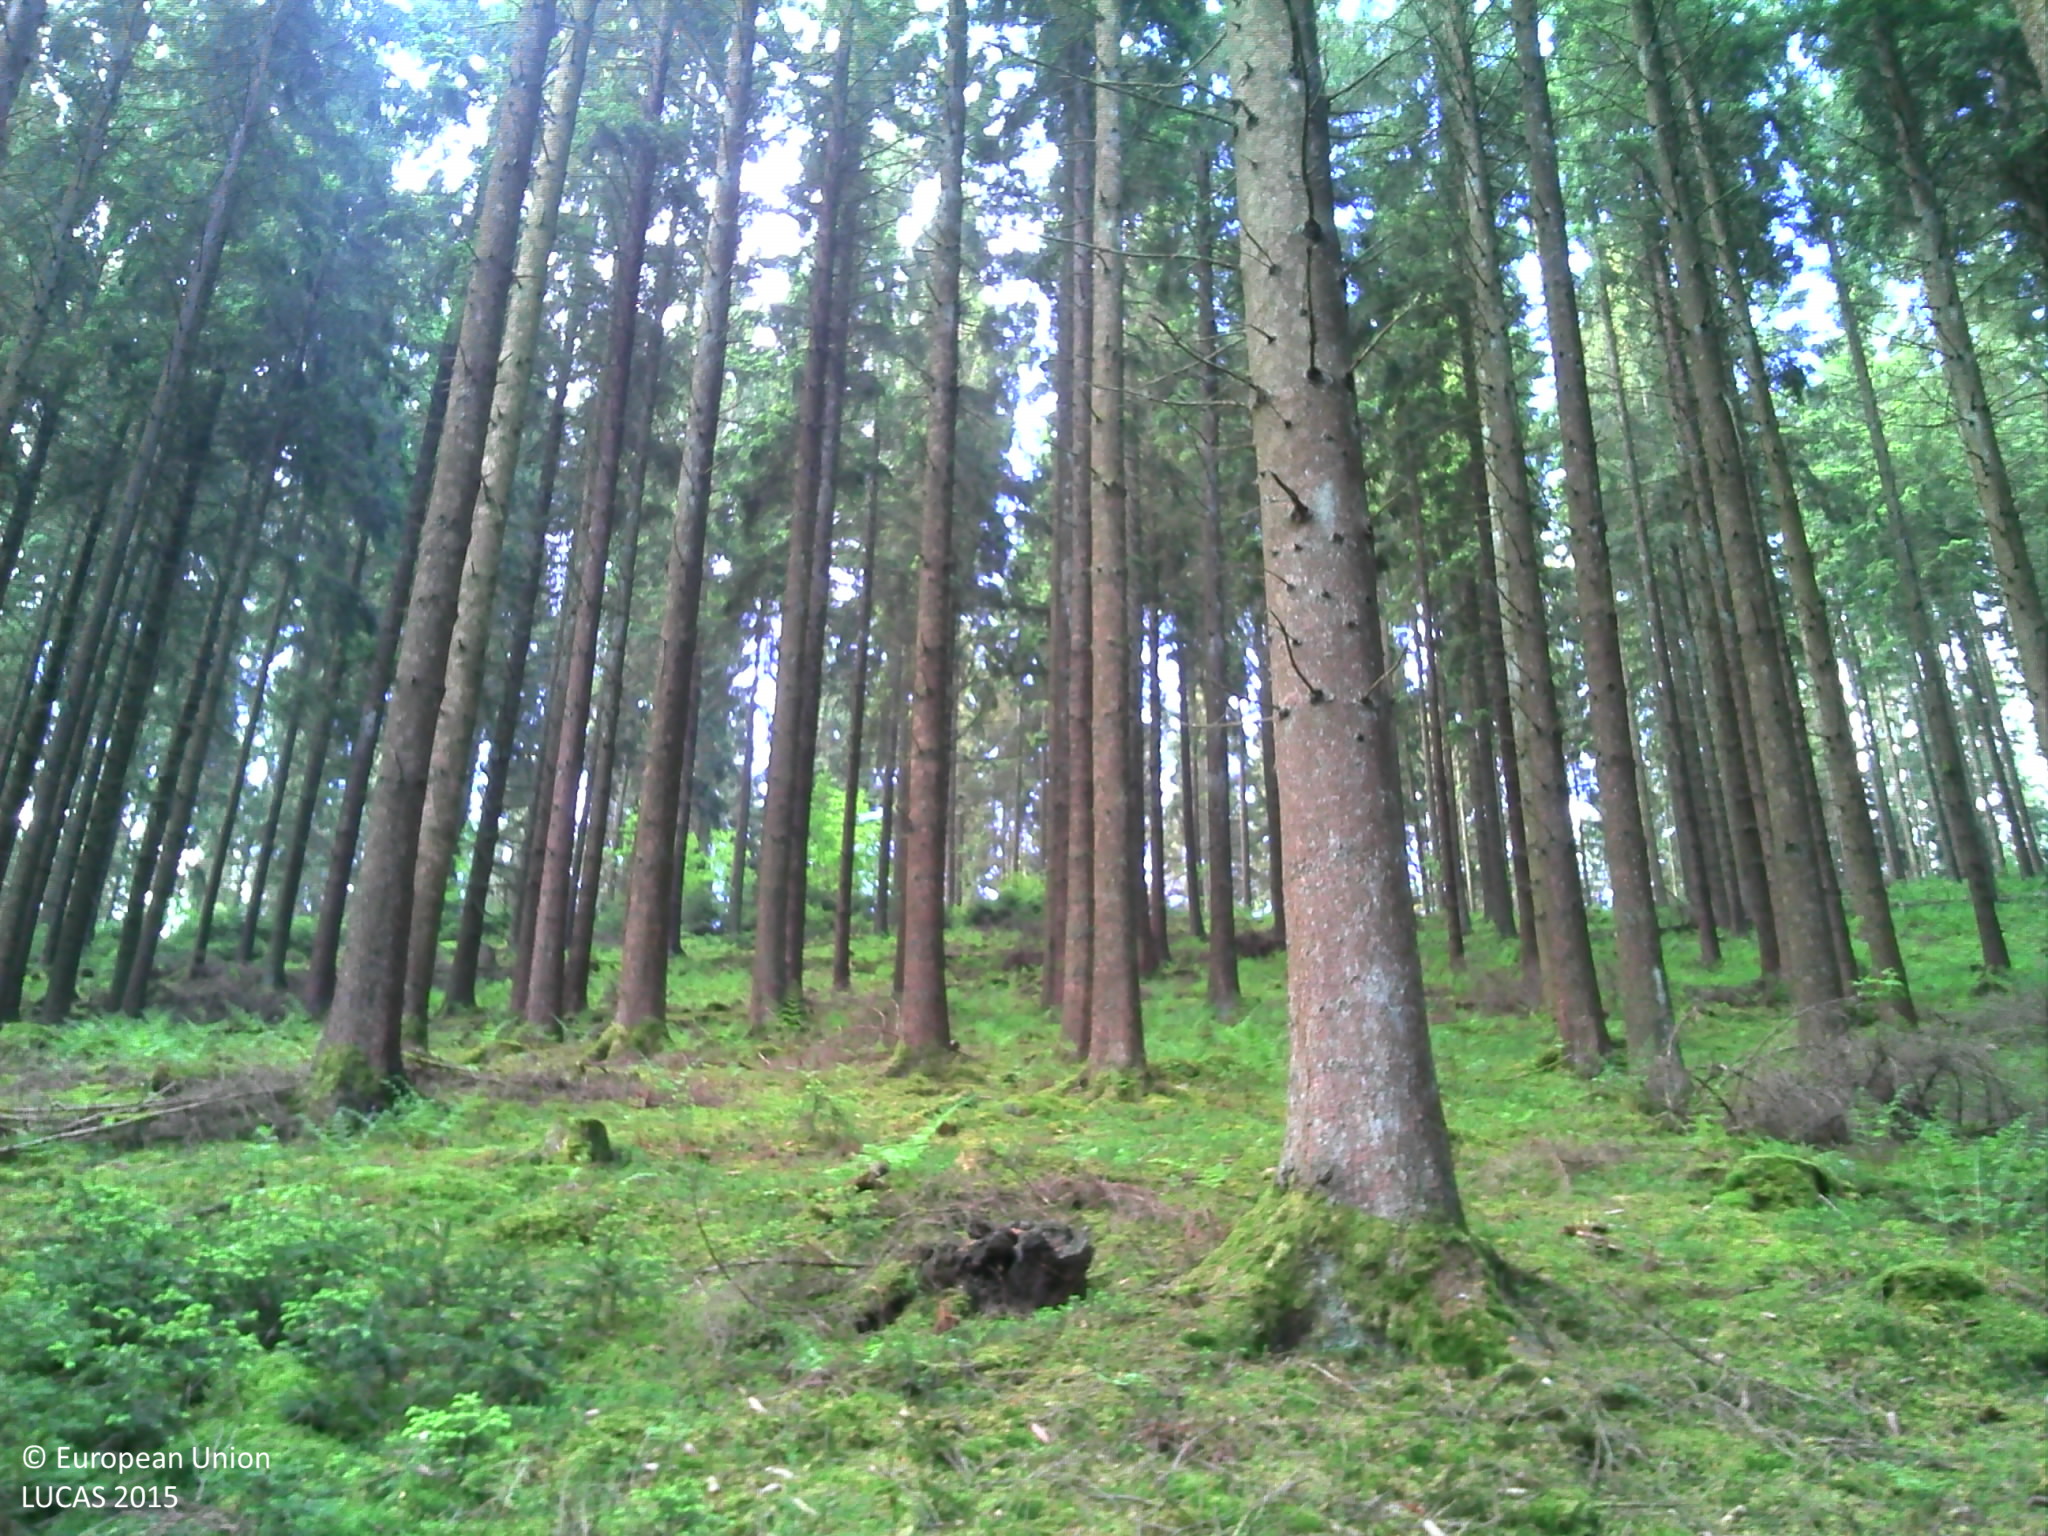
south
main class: Woodland
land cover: Spruce dominated coniferous woodland
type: exotic forest
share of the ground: > 75 %
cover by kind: coniferous forest trees 100 %
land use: Forestry
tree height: > 5 m
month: May
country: LU
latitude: 50.0607
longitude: 6.0180
